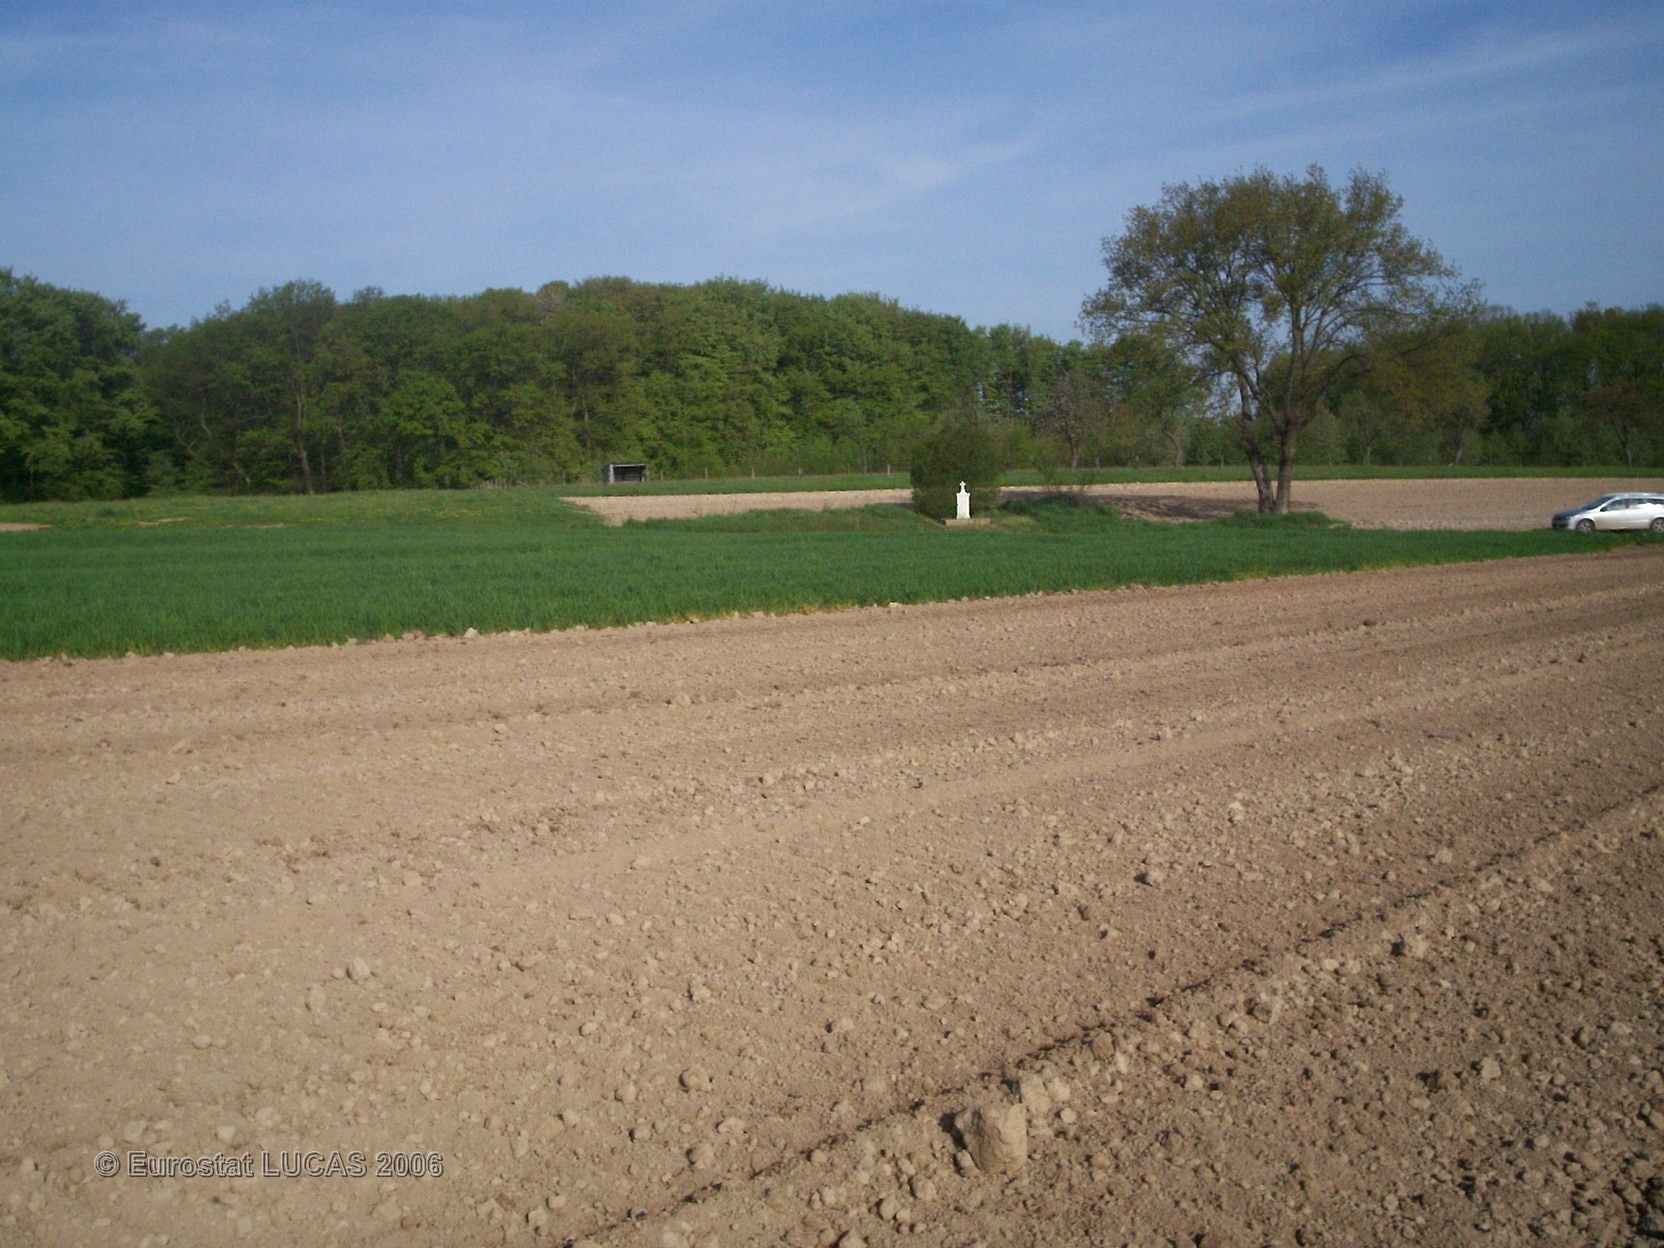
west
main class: Cropland
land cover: Maize
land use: Agriculture (excluding fallow land and kitchen gardens)
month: May
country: FR
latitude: 49.0089
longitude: 6.9243
